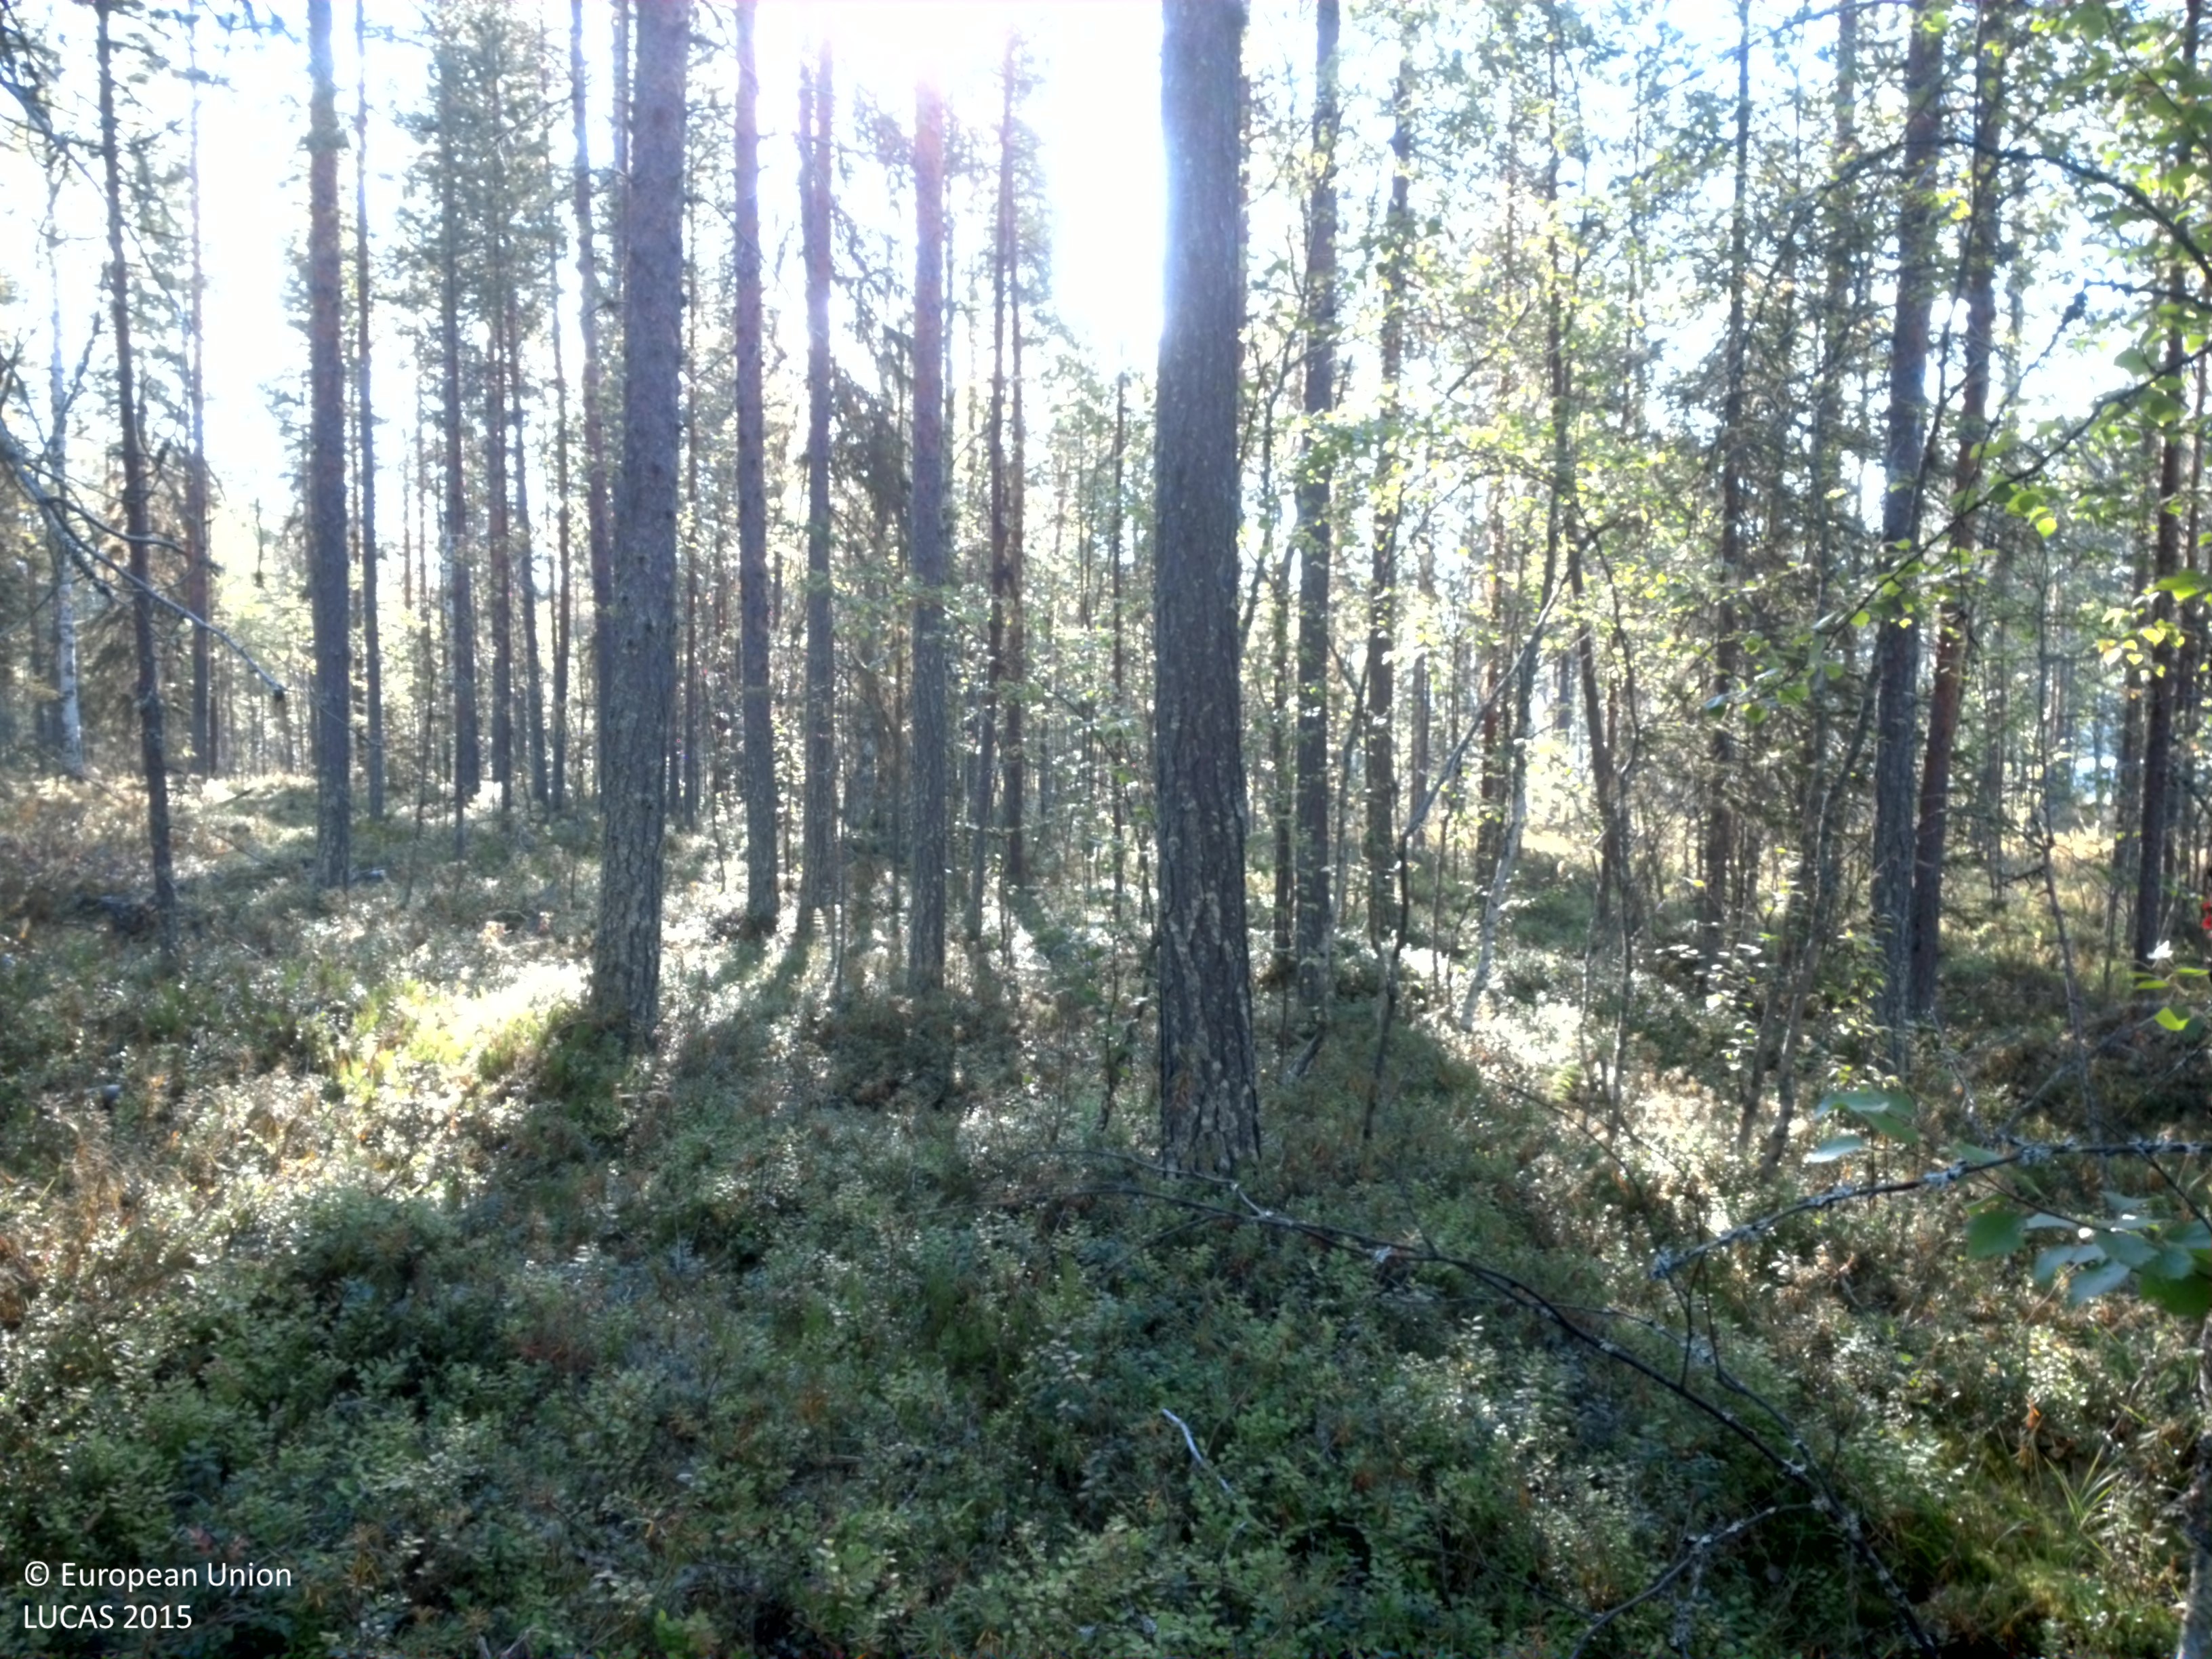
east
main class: Woodland
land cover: Pine dominated mixed woodland
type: boreal forest
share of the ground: 50 - 75 %
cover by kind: coniferous forest trees 45 %, shrubs 35 %, broadleaved forest trees 15 %, lichens and mosses 5 %
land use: Forestry
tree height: > 5 m
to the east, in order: Pine dominated mixed woodland; Pine dominated coniferous woodland; Pine dominated mixed woodland
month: August
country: SE
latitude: 64.5542
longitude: 18.7923
